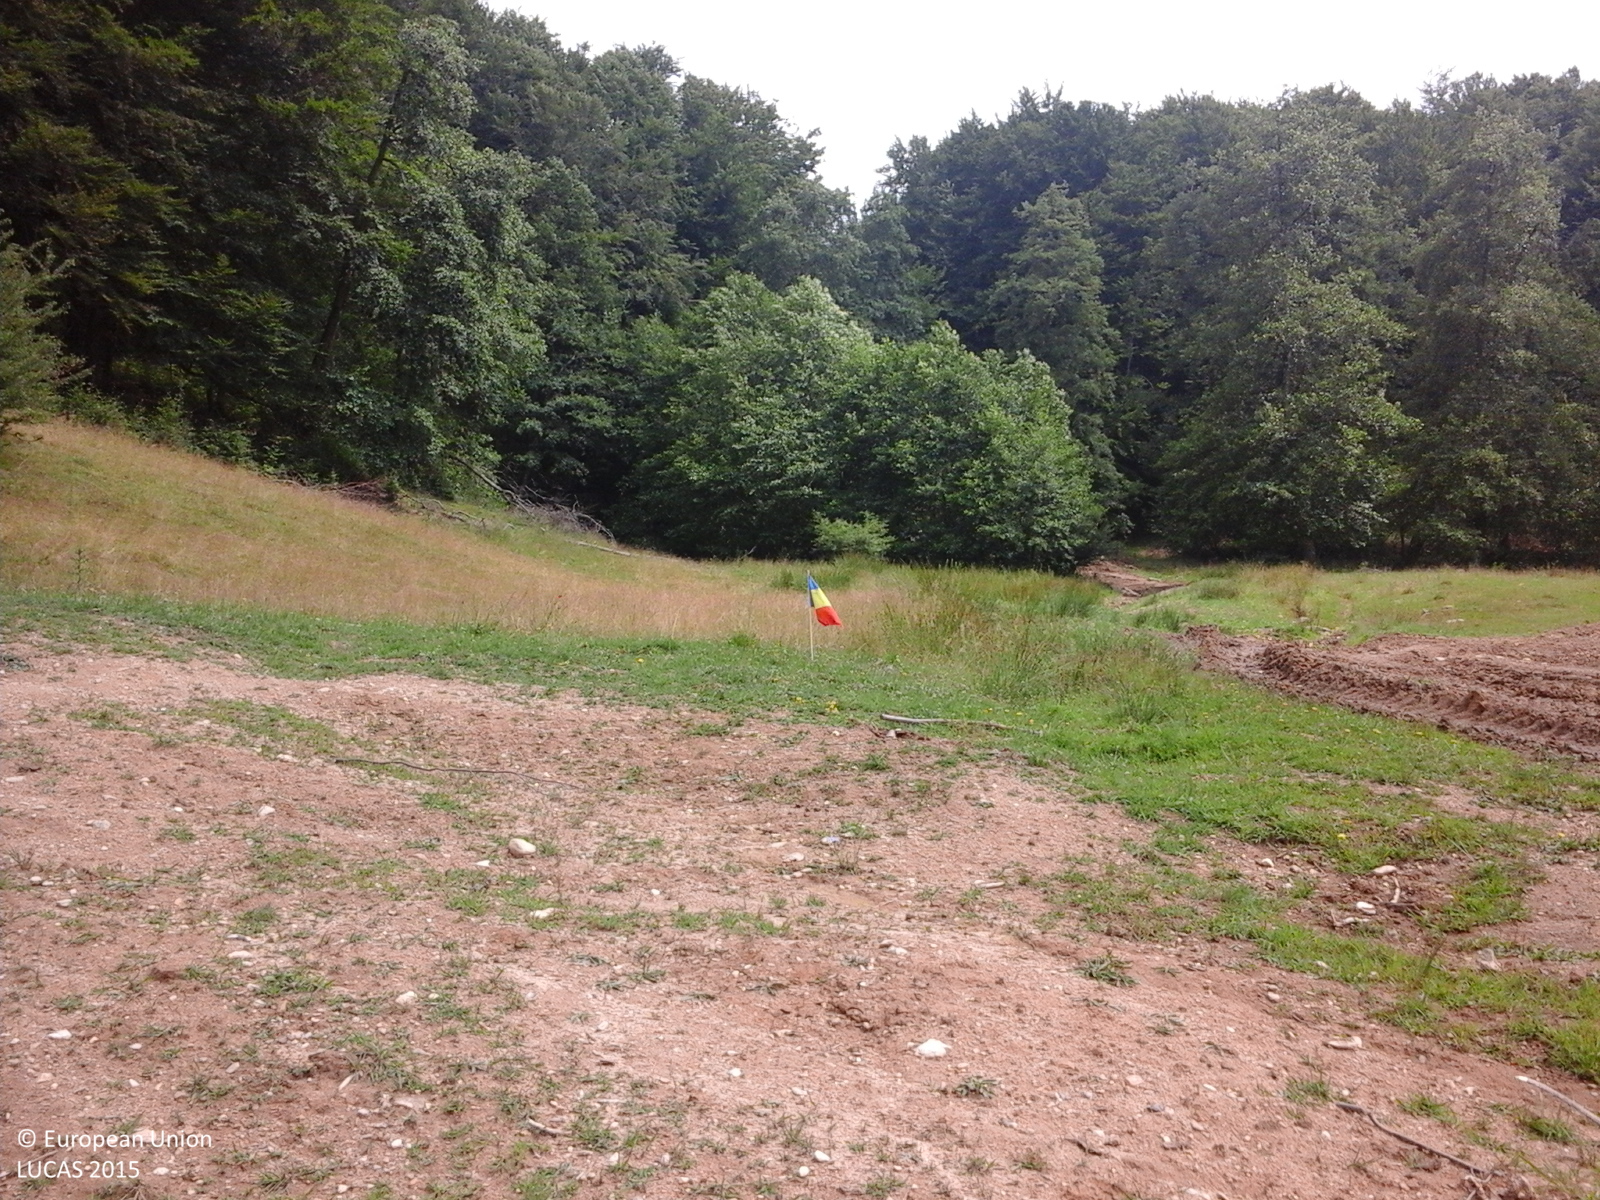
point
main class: Grassland
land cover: Grassland with sparse tree/shrub cover
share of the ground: > 75 %
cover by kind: herbaceous plants 85 %, unconsolidated bare surface 10 %, broadleaved forest trees 5 %
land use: Agriculture (excluding fallow land and kitchen gardens)
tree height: < 5 m
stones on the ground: 10 - 25 %
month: July
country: RO
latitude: 45.2839
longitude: 24.8872
